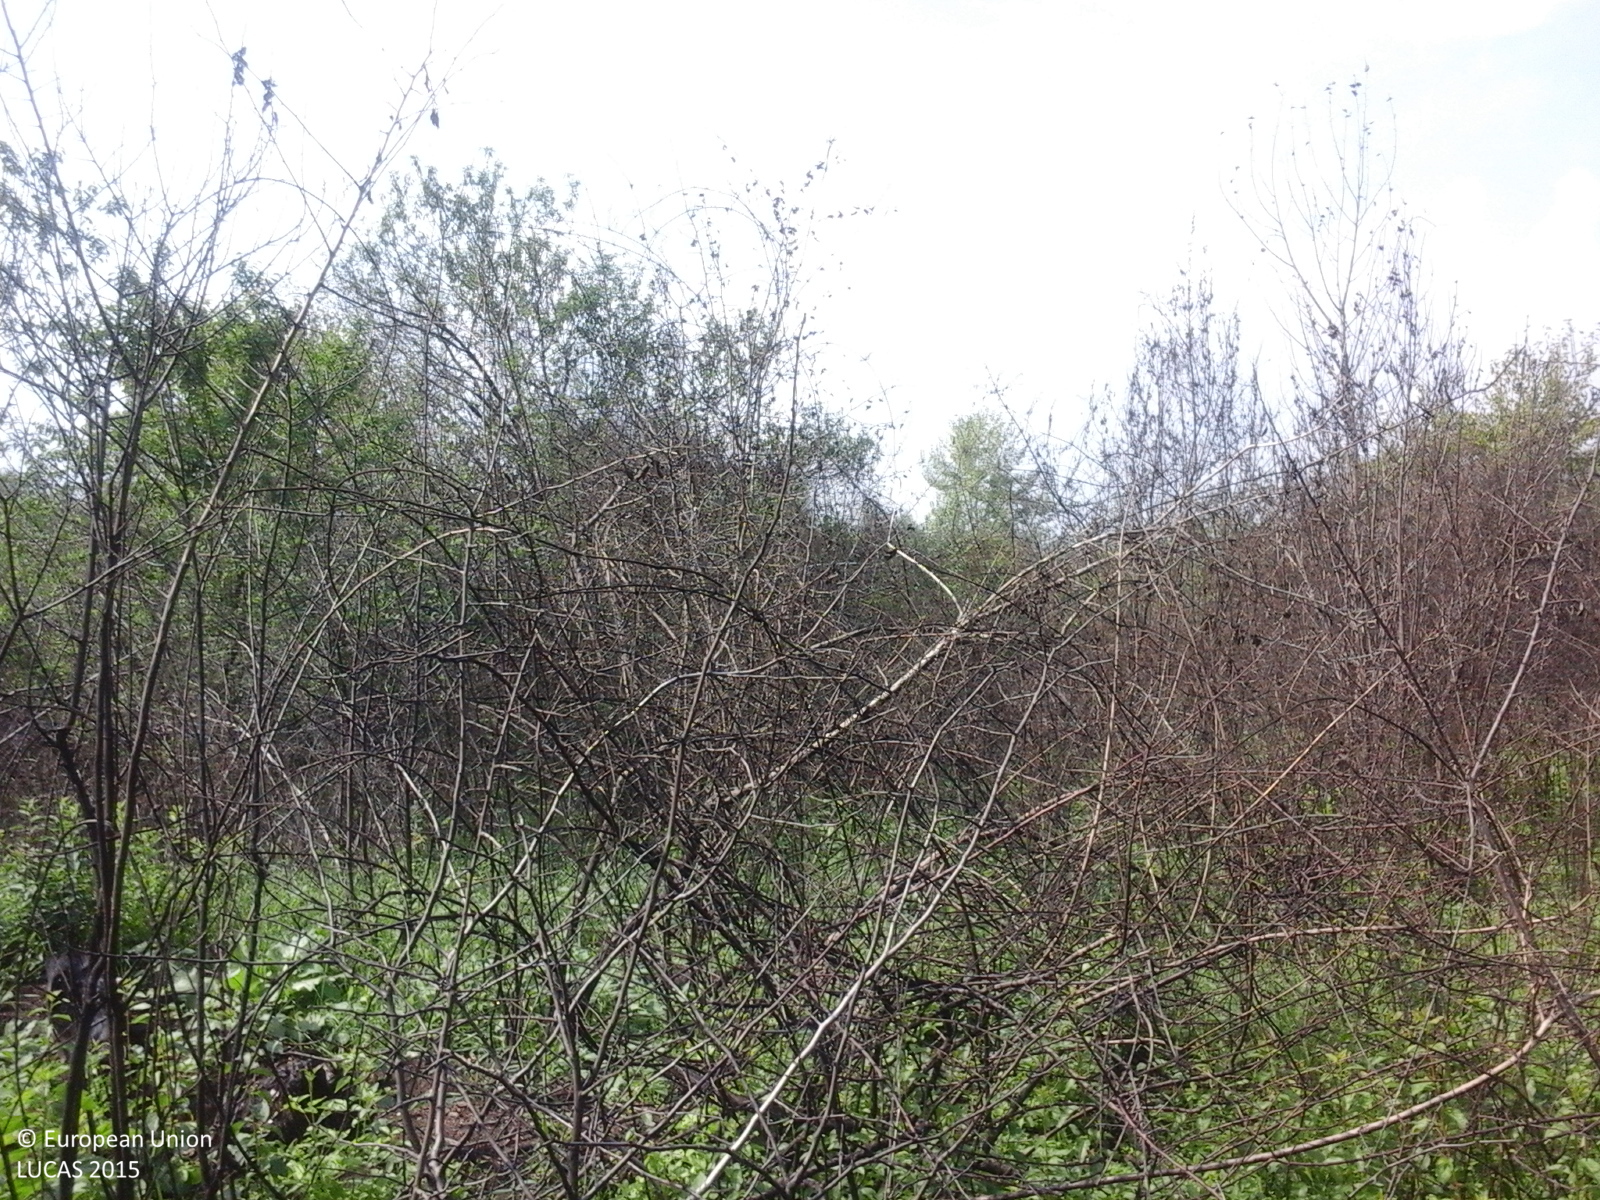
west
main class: Shrubland
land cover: Shrubland with sparse tree cover
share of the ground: > 75 %
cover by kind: shrubs 95 %, broadleaved forest trees 5 %
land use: Semi-natural and natural areas not in use
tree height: > 5 m
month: September
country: RO
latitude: 44.9780
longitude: 23.2283
